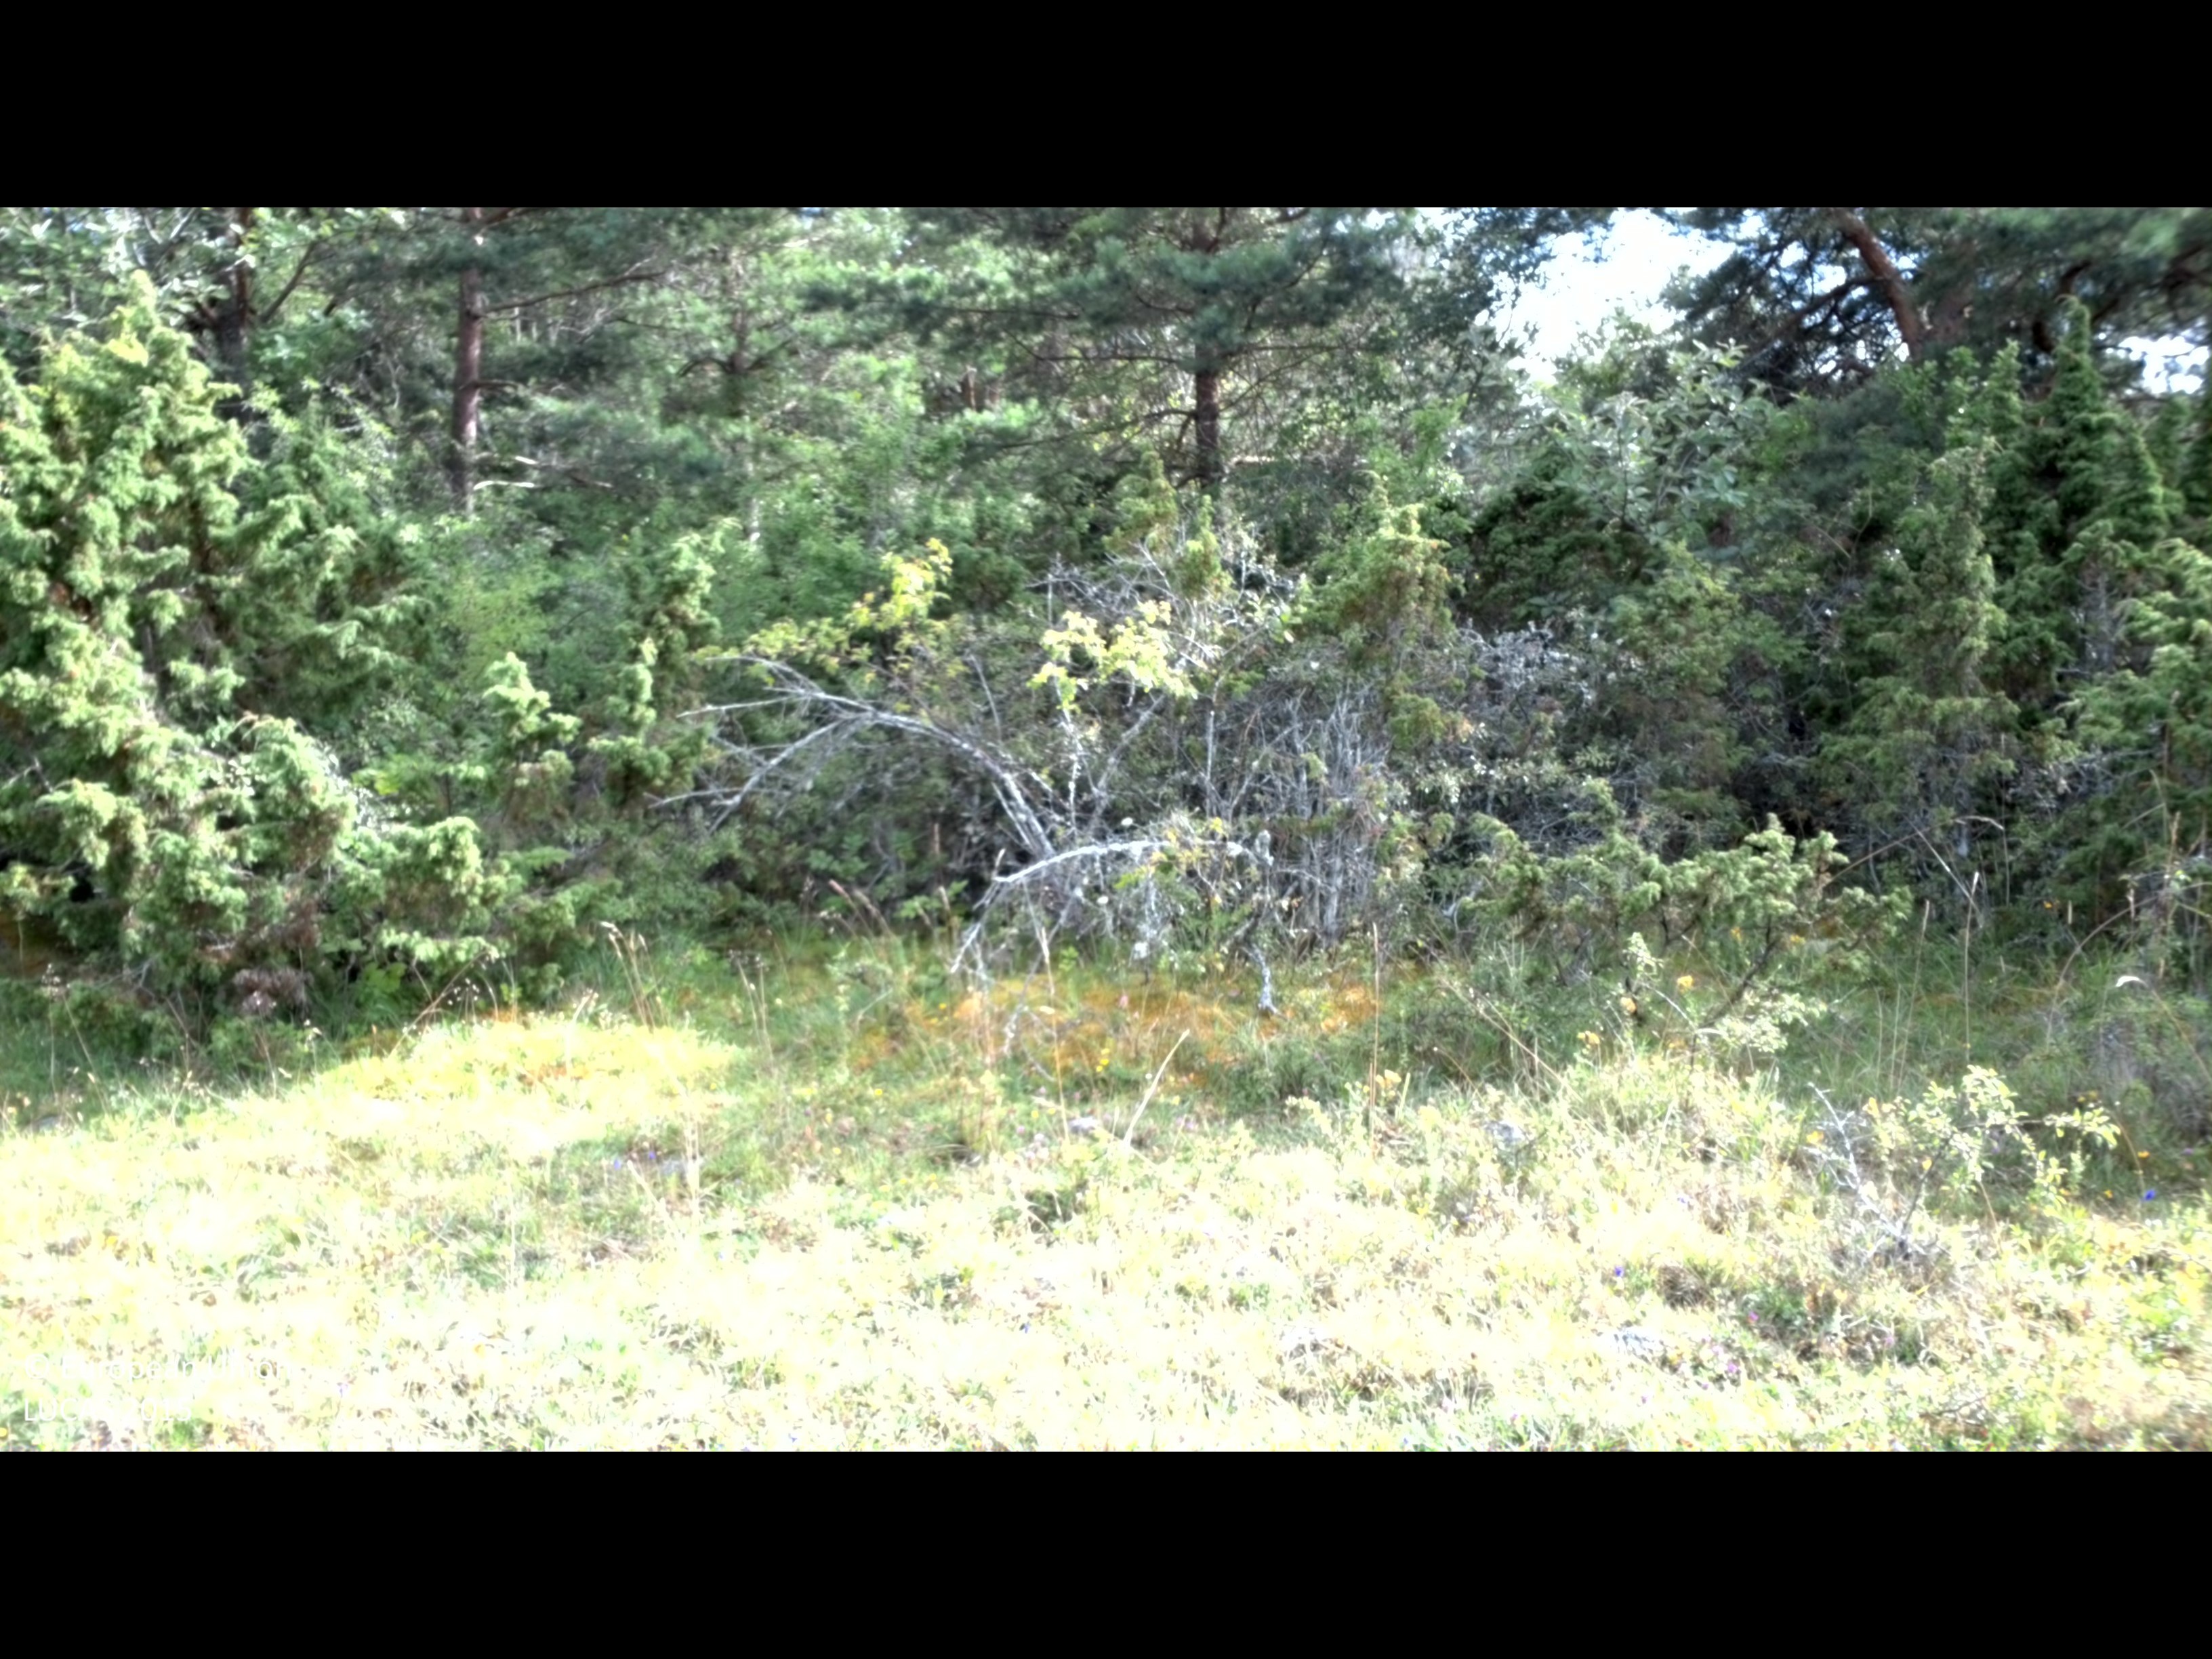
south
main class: Grassland
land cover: Grassland without tree/shrub cover
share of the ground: > 75 %
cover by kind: herbaceous plants 95 %, shrubs 5 %
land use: Agriculture (excluding fallow land and kitchen gardens)
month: July
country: SE
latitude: 57.1738
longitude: 16.9318
